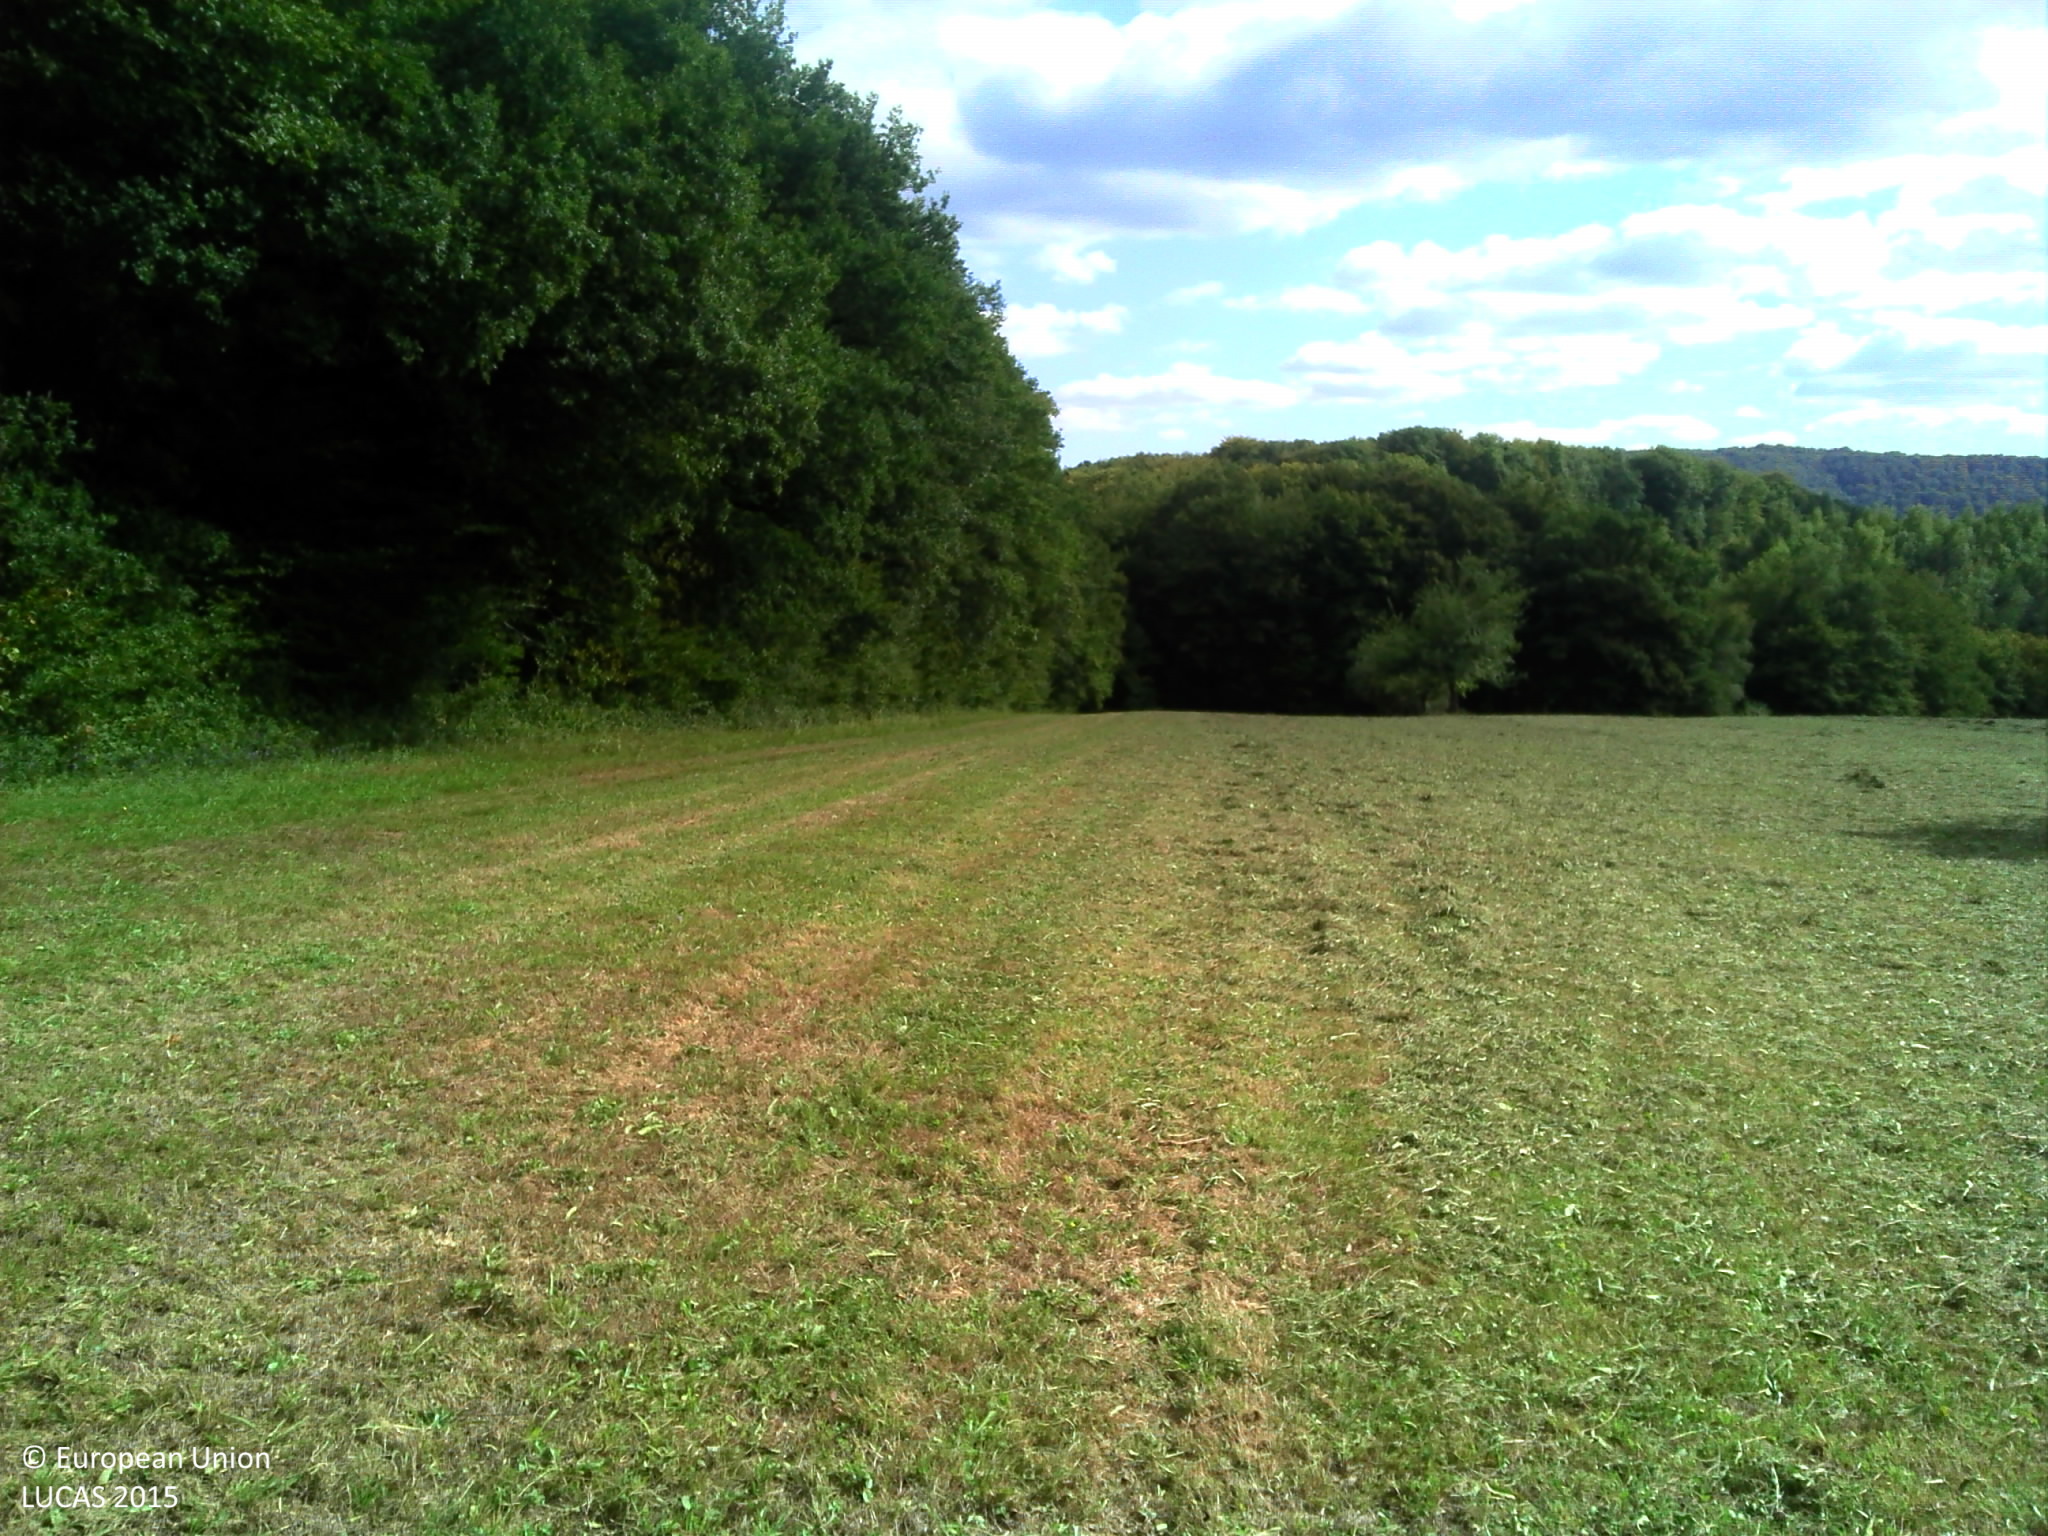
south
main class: Grassland
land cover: Grassland with sparse tree/shrub cover
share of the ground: > 75 %
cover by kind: herbaceous plants 95 %, broadleaved forest trees 5 %
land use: Agriculture (excluding fallow land and kitchen gardens)
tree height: > 5 m
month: September
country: FR
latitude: 47.3455
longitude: 6.1498
